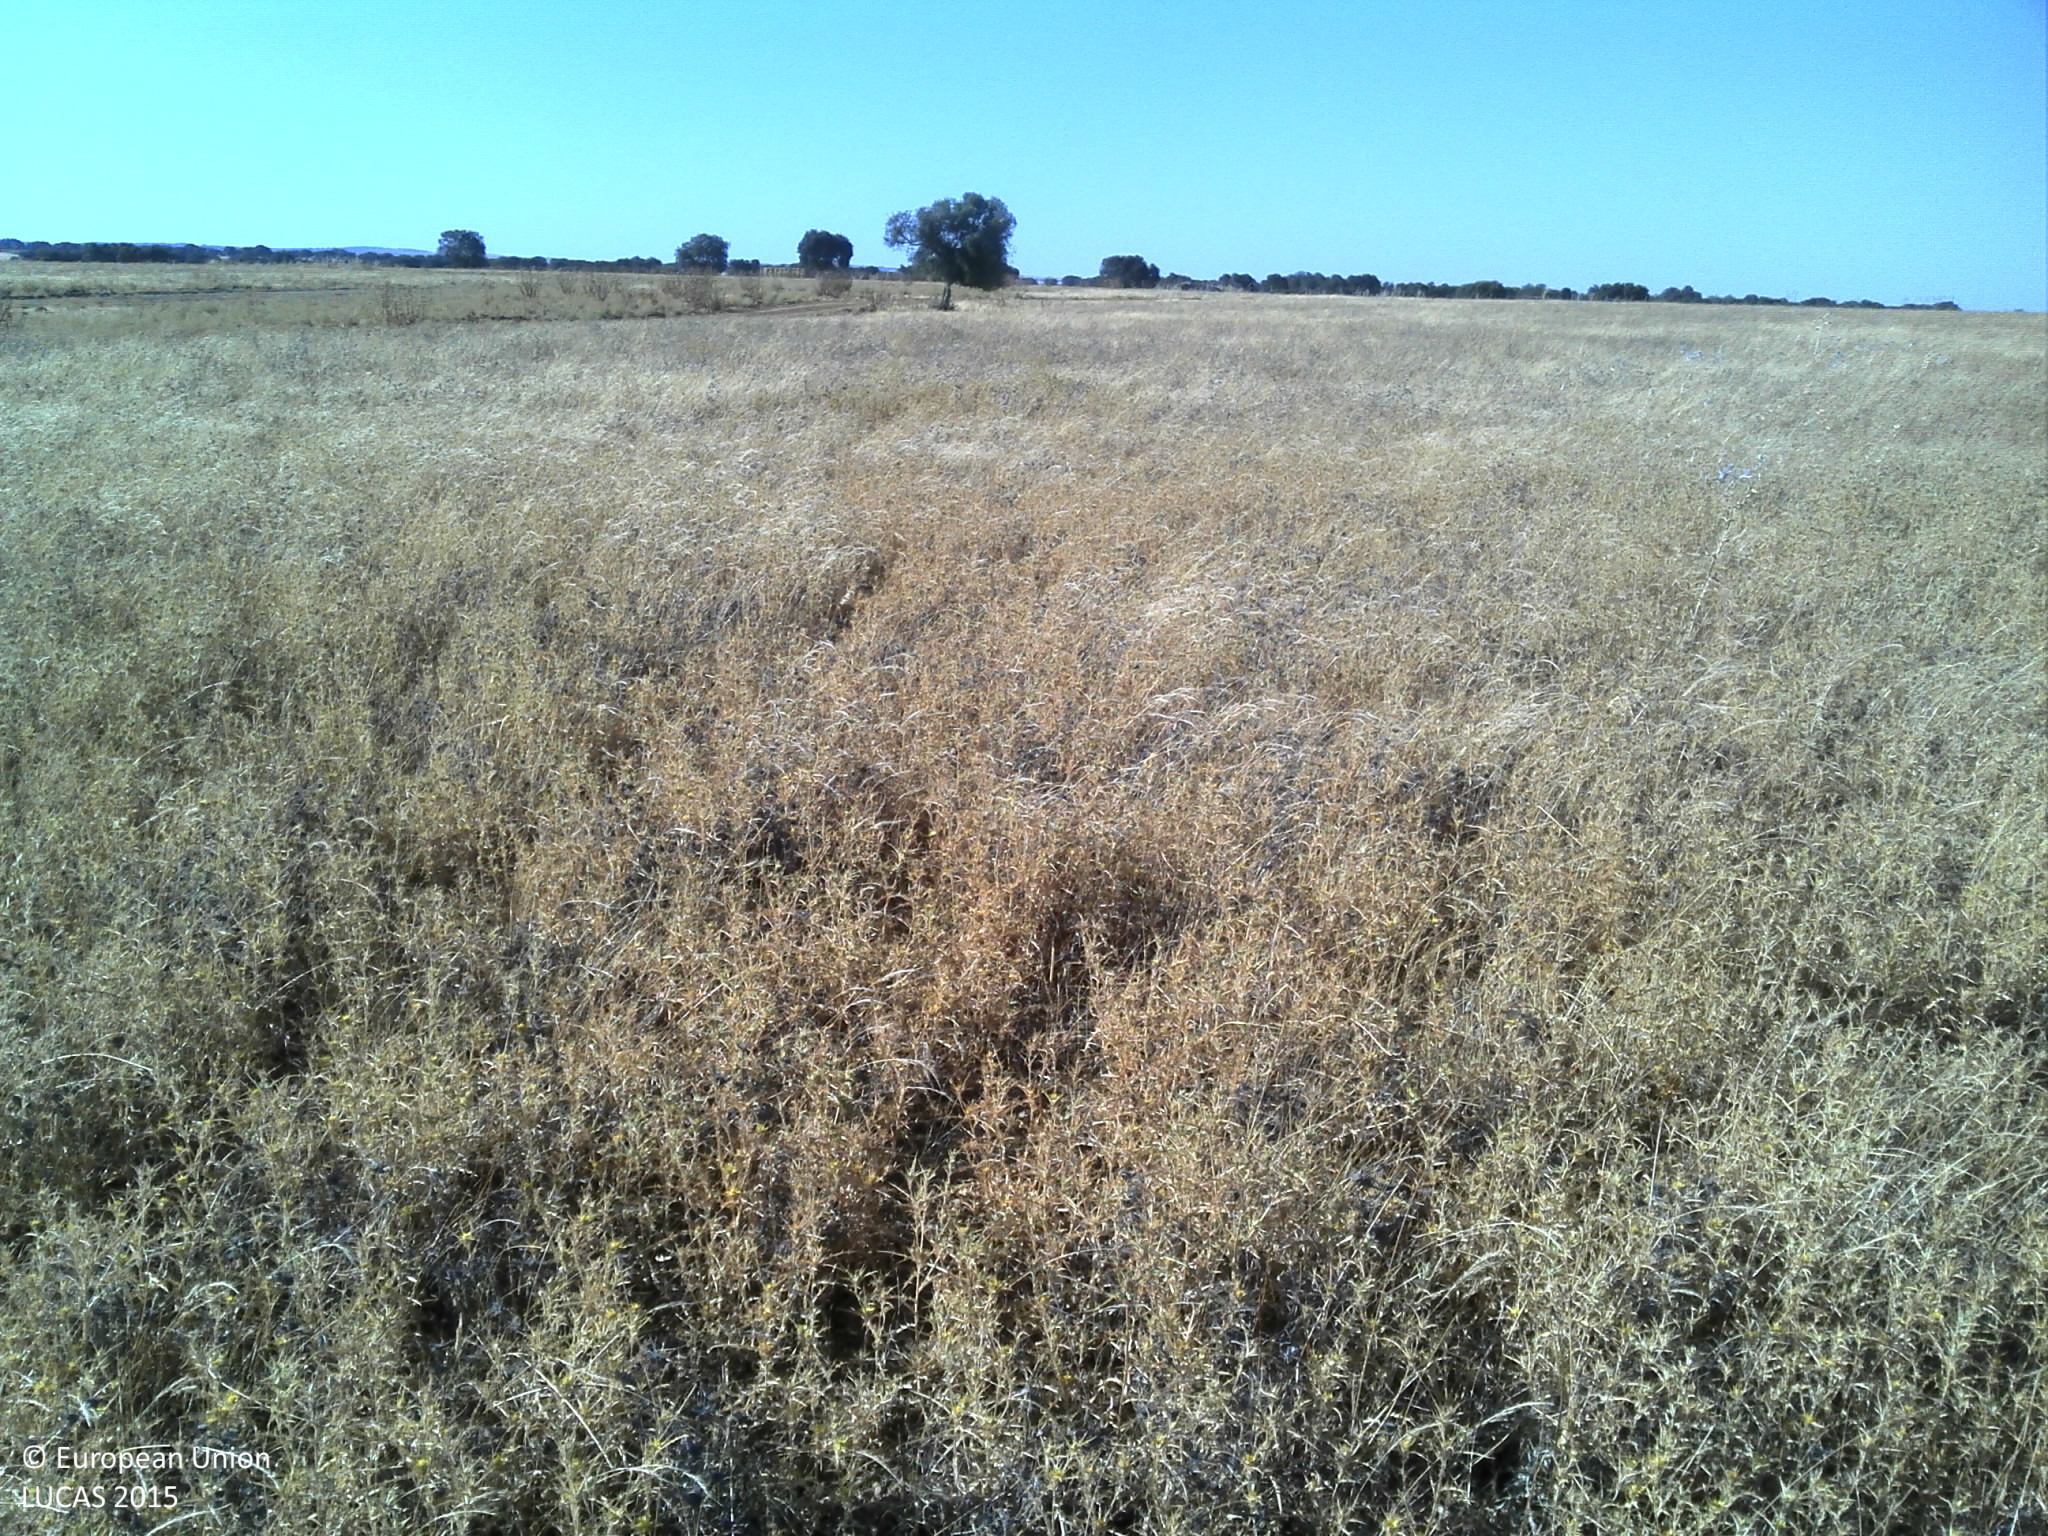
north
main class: Grassland
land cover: Grassland without tree/shrub cover
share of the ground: 50 - 75 %
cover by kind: herbaceous plants 70 %, unconsolidated bare surface 25 %
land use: Agriculture (excluding fallow land and kitchen gardens)
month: July
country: PT
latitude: 37.9010
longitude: -8.0090
